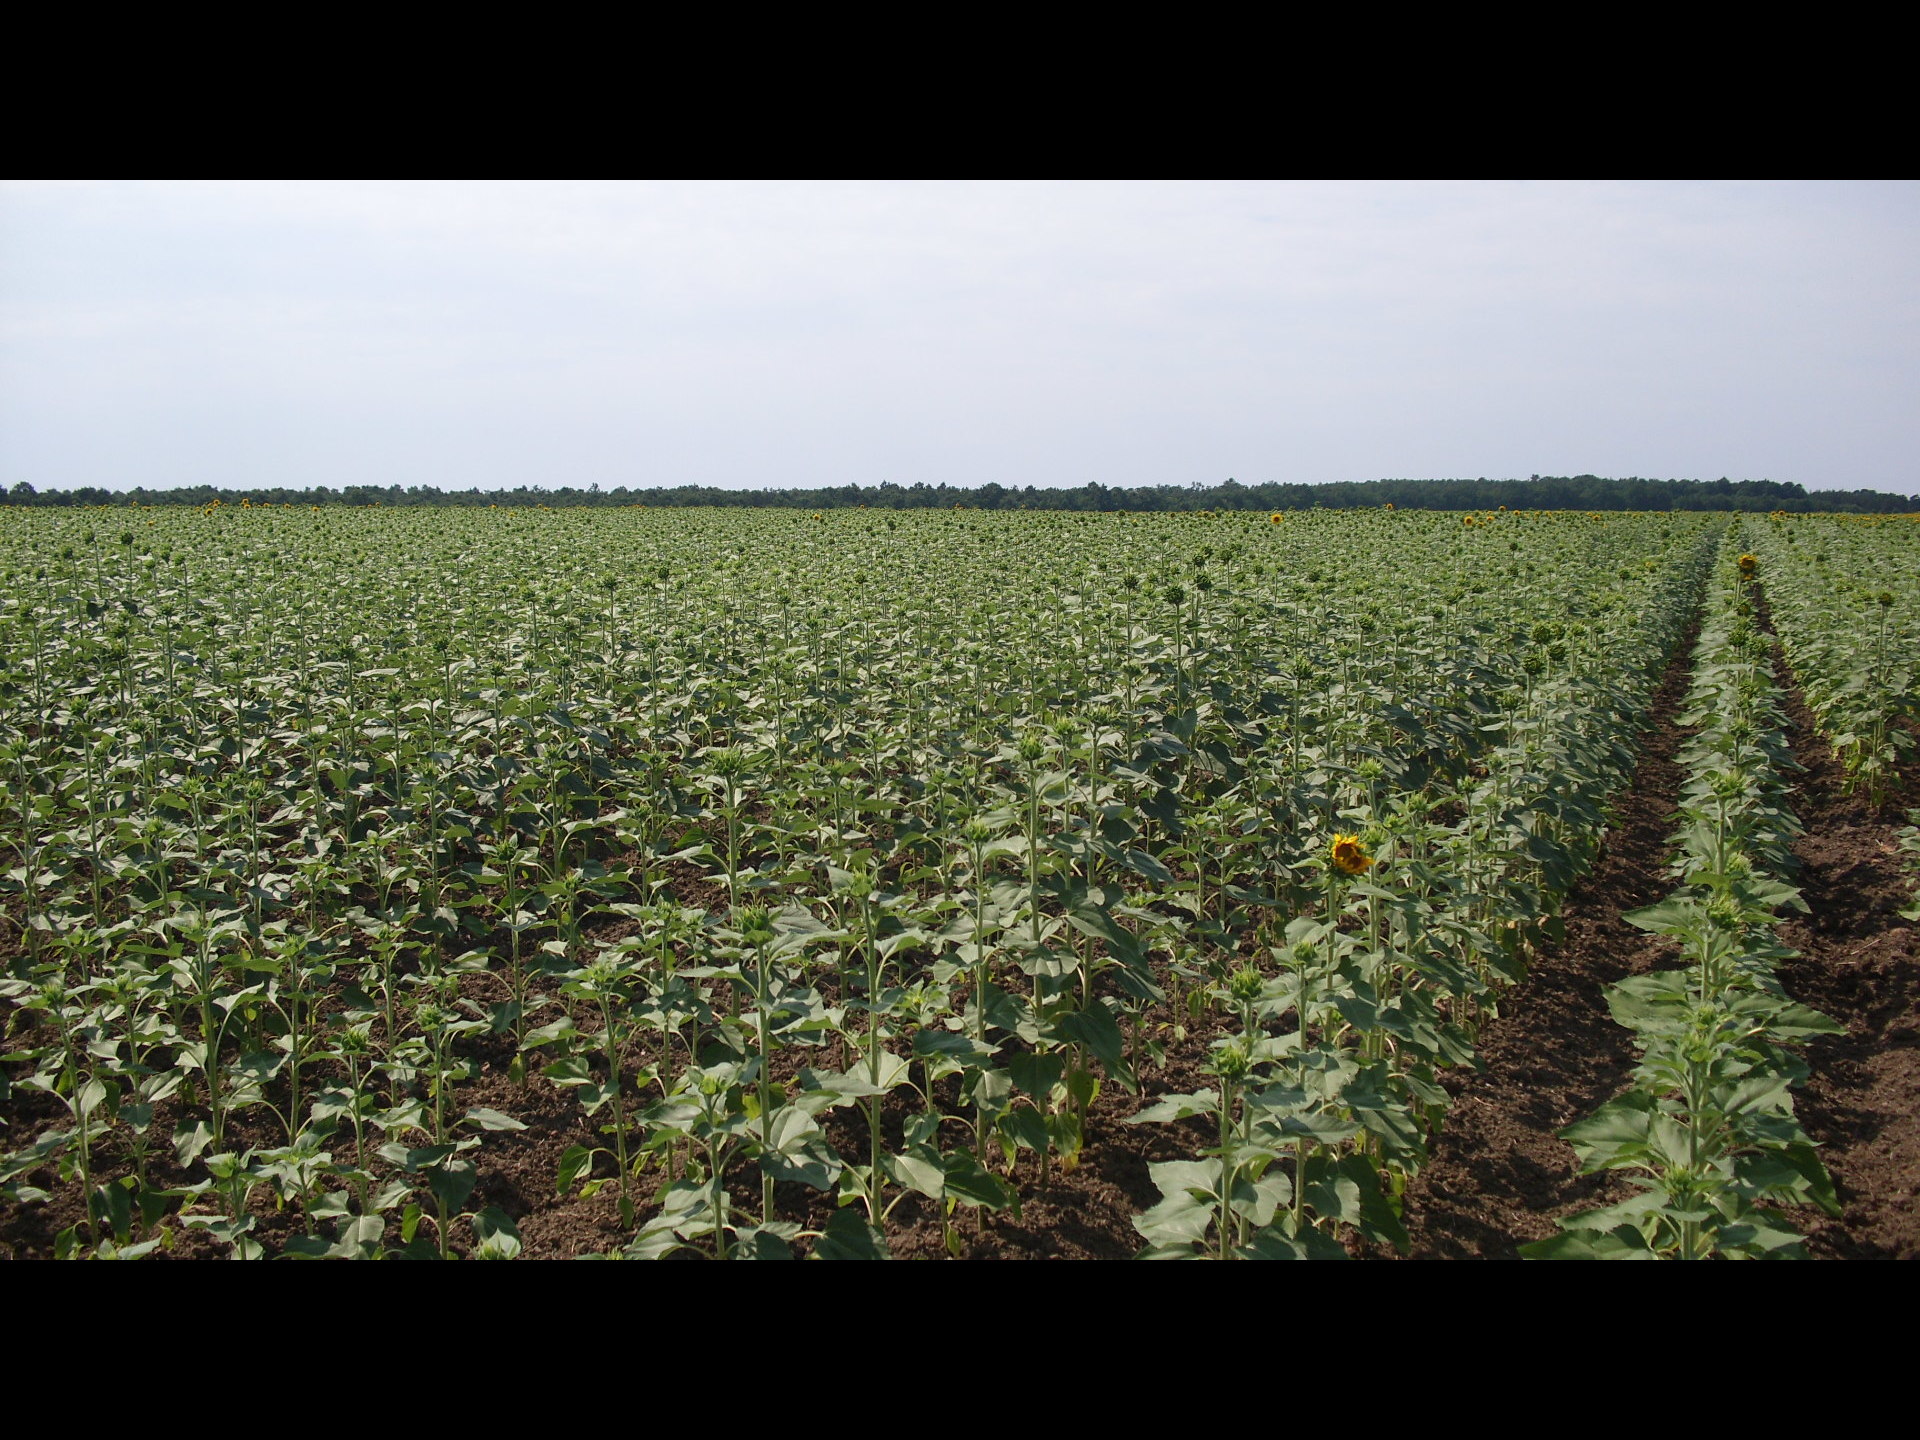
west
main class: Cropland
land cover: Sunflower
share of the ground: 25 - 50 %
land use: Agriculture (excluding fallow land and kitchen gardens)
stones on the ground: < 10 %
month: August
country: BG
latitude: 43.3470
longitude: 23.2767
